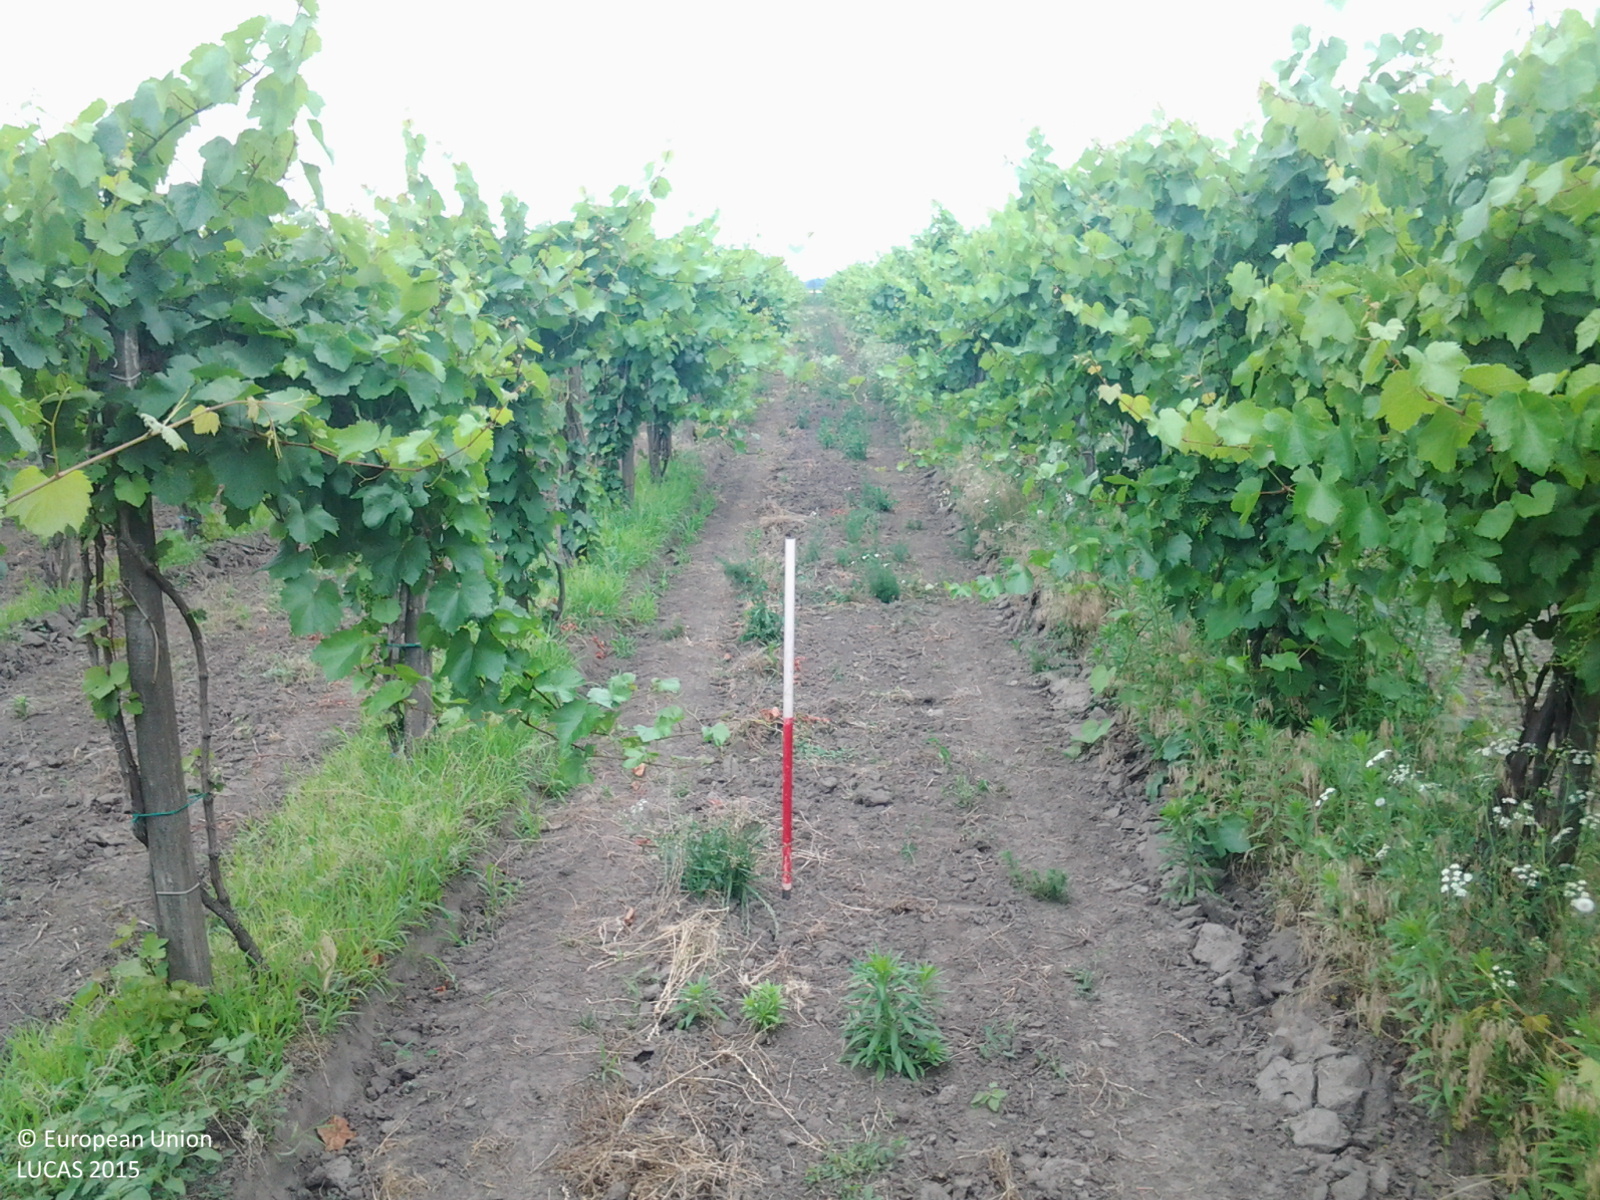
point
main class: Cropland
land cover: Vineyards
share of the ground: 25 - 50 %
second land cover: Other bare soil
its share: > 75 %
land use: Agriculture (excluding fallow land and kitchen gardens)
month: June
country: HU
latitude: 46.4037
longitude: 19.0275
